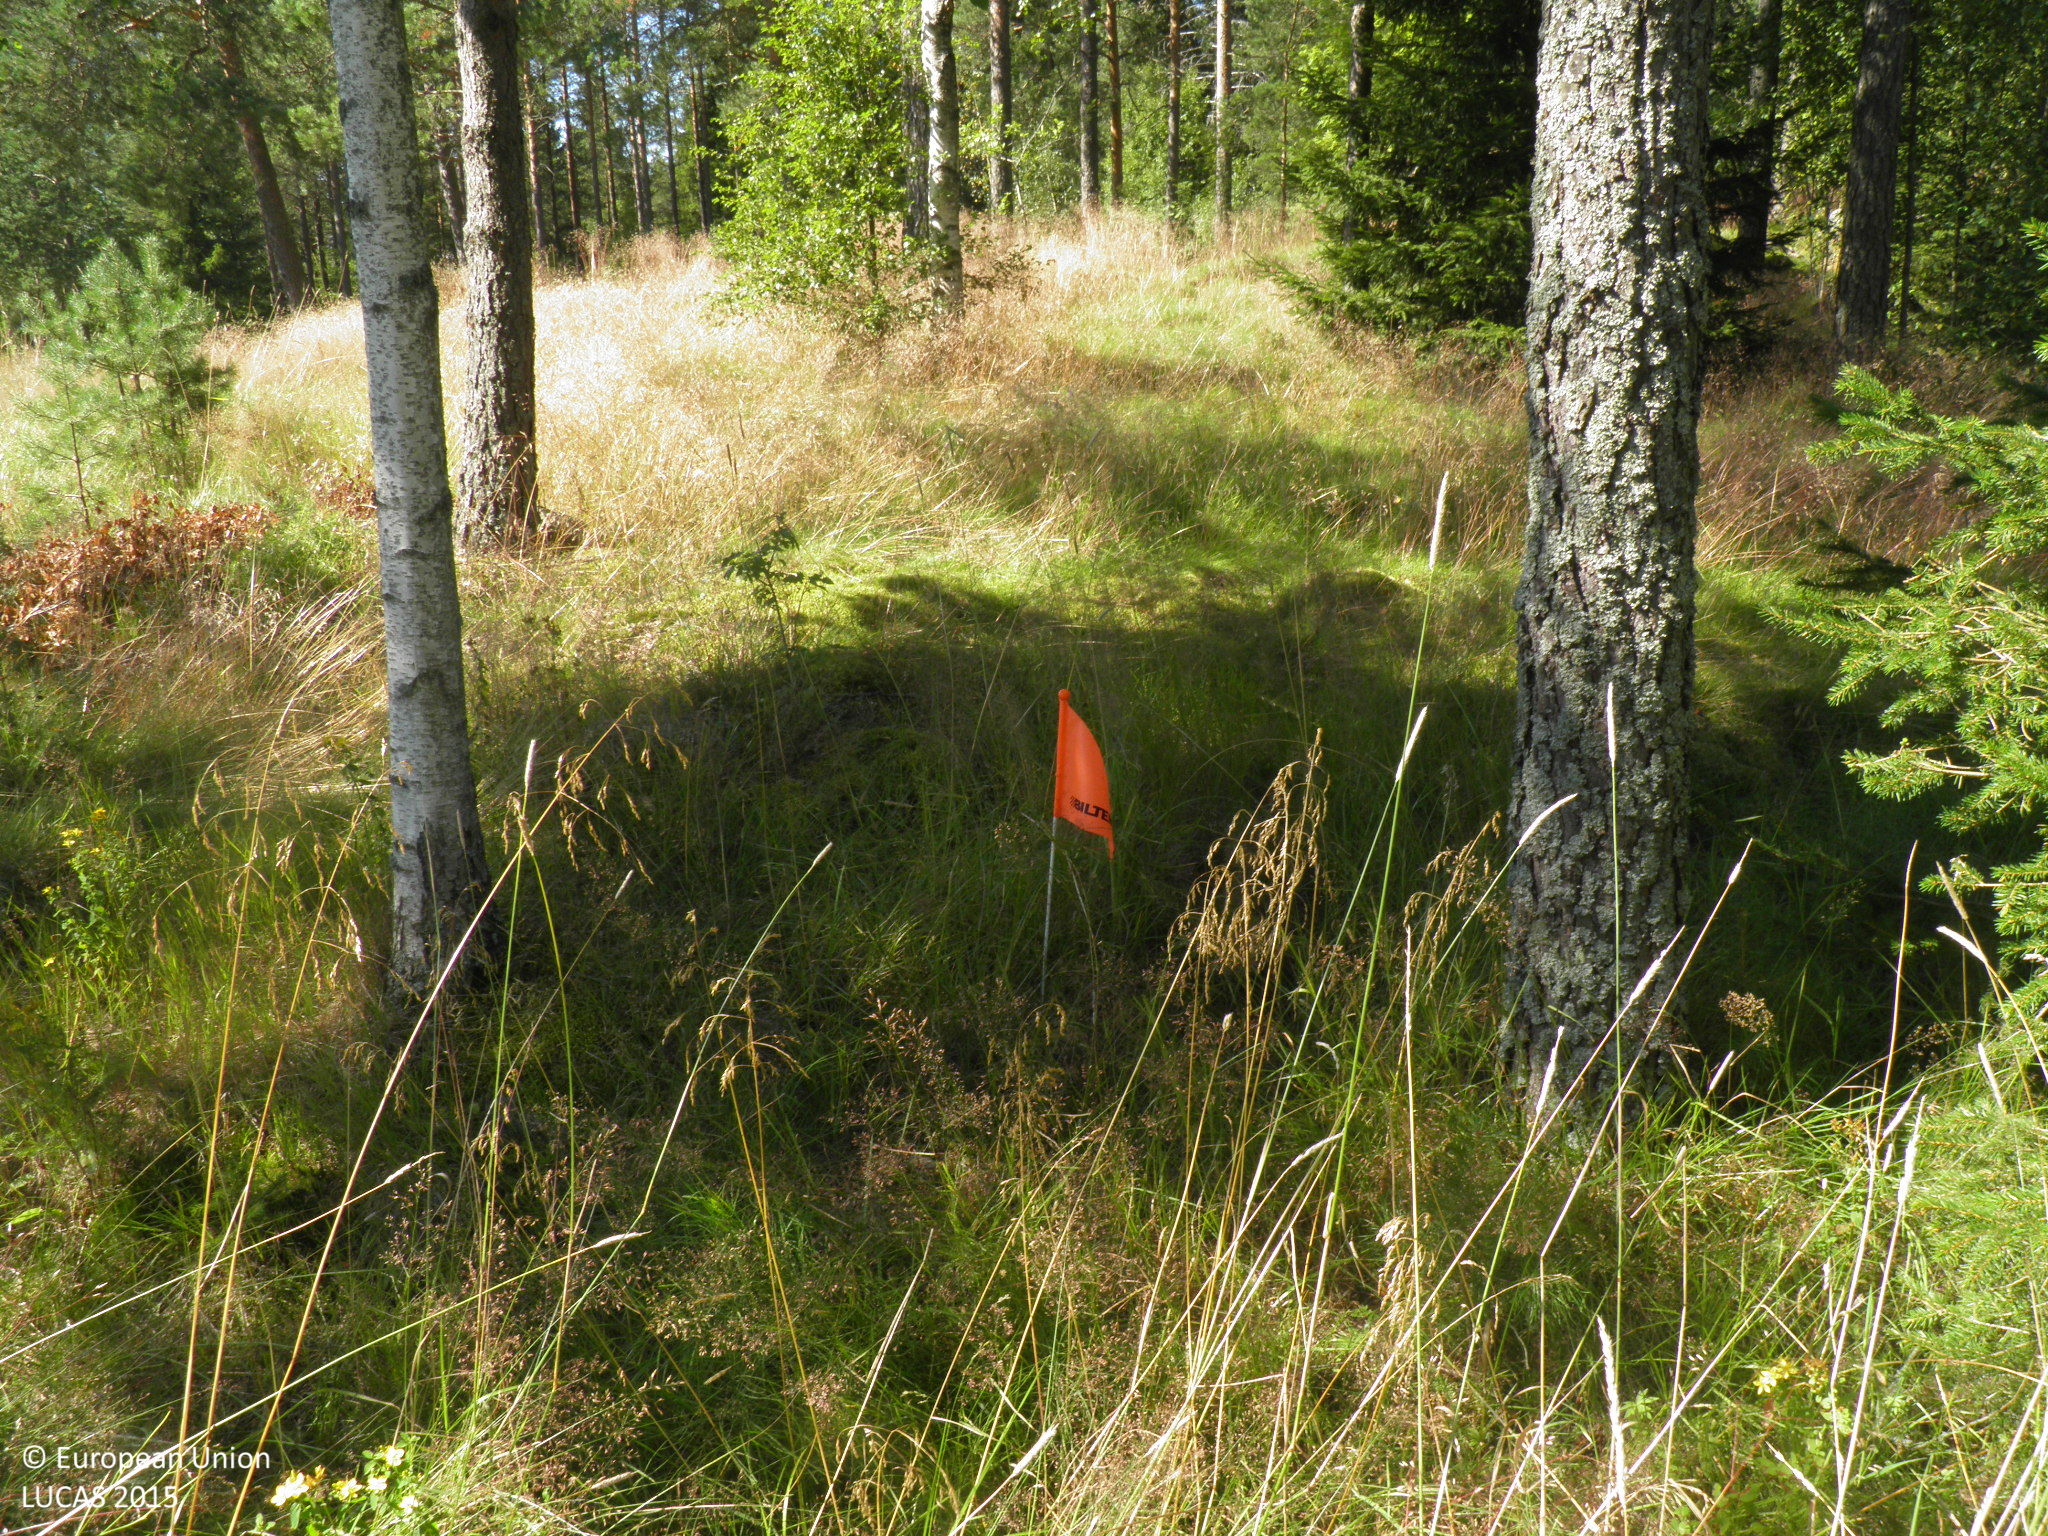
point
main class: Woodland
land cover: Pine dominated mixed woodland
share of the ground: 50 - 75 %
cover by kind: coniferous forest trees 30 %, shrubs 25 %, herbaceous plants 25 %, broadleaved forest trees 20 %
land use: Forestry
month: August
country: FI
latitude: 60.7812
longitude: 21.5334
